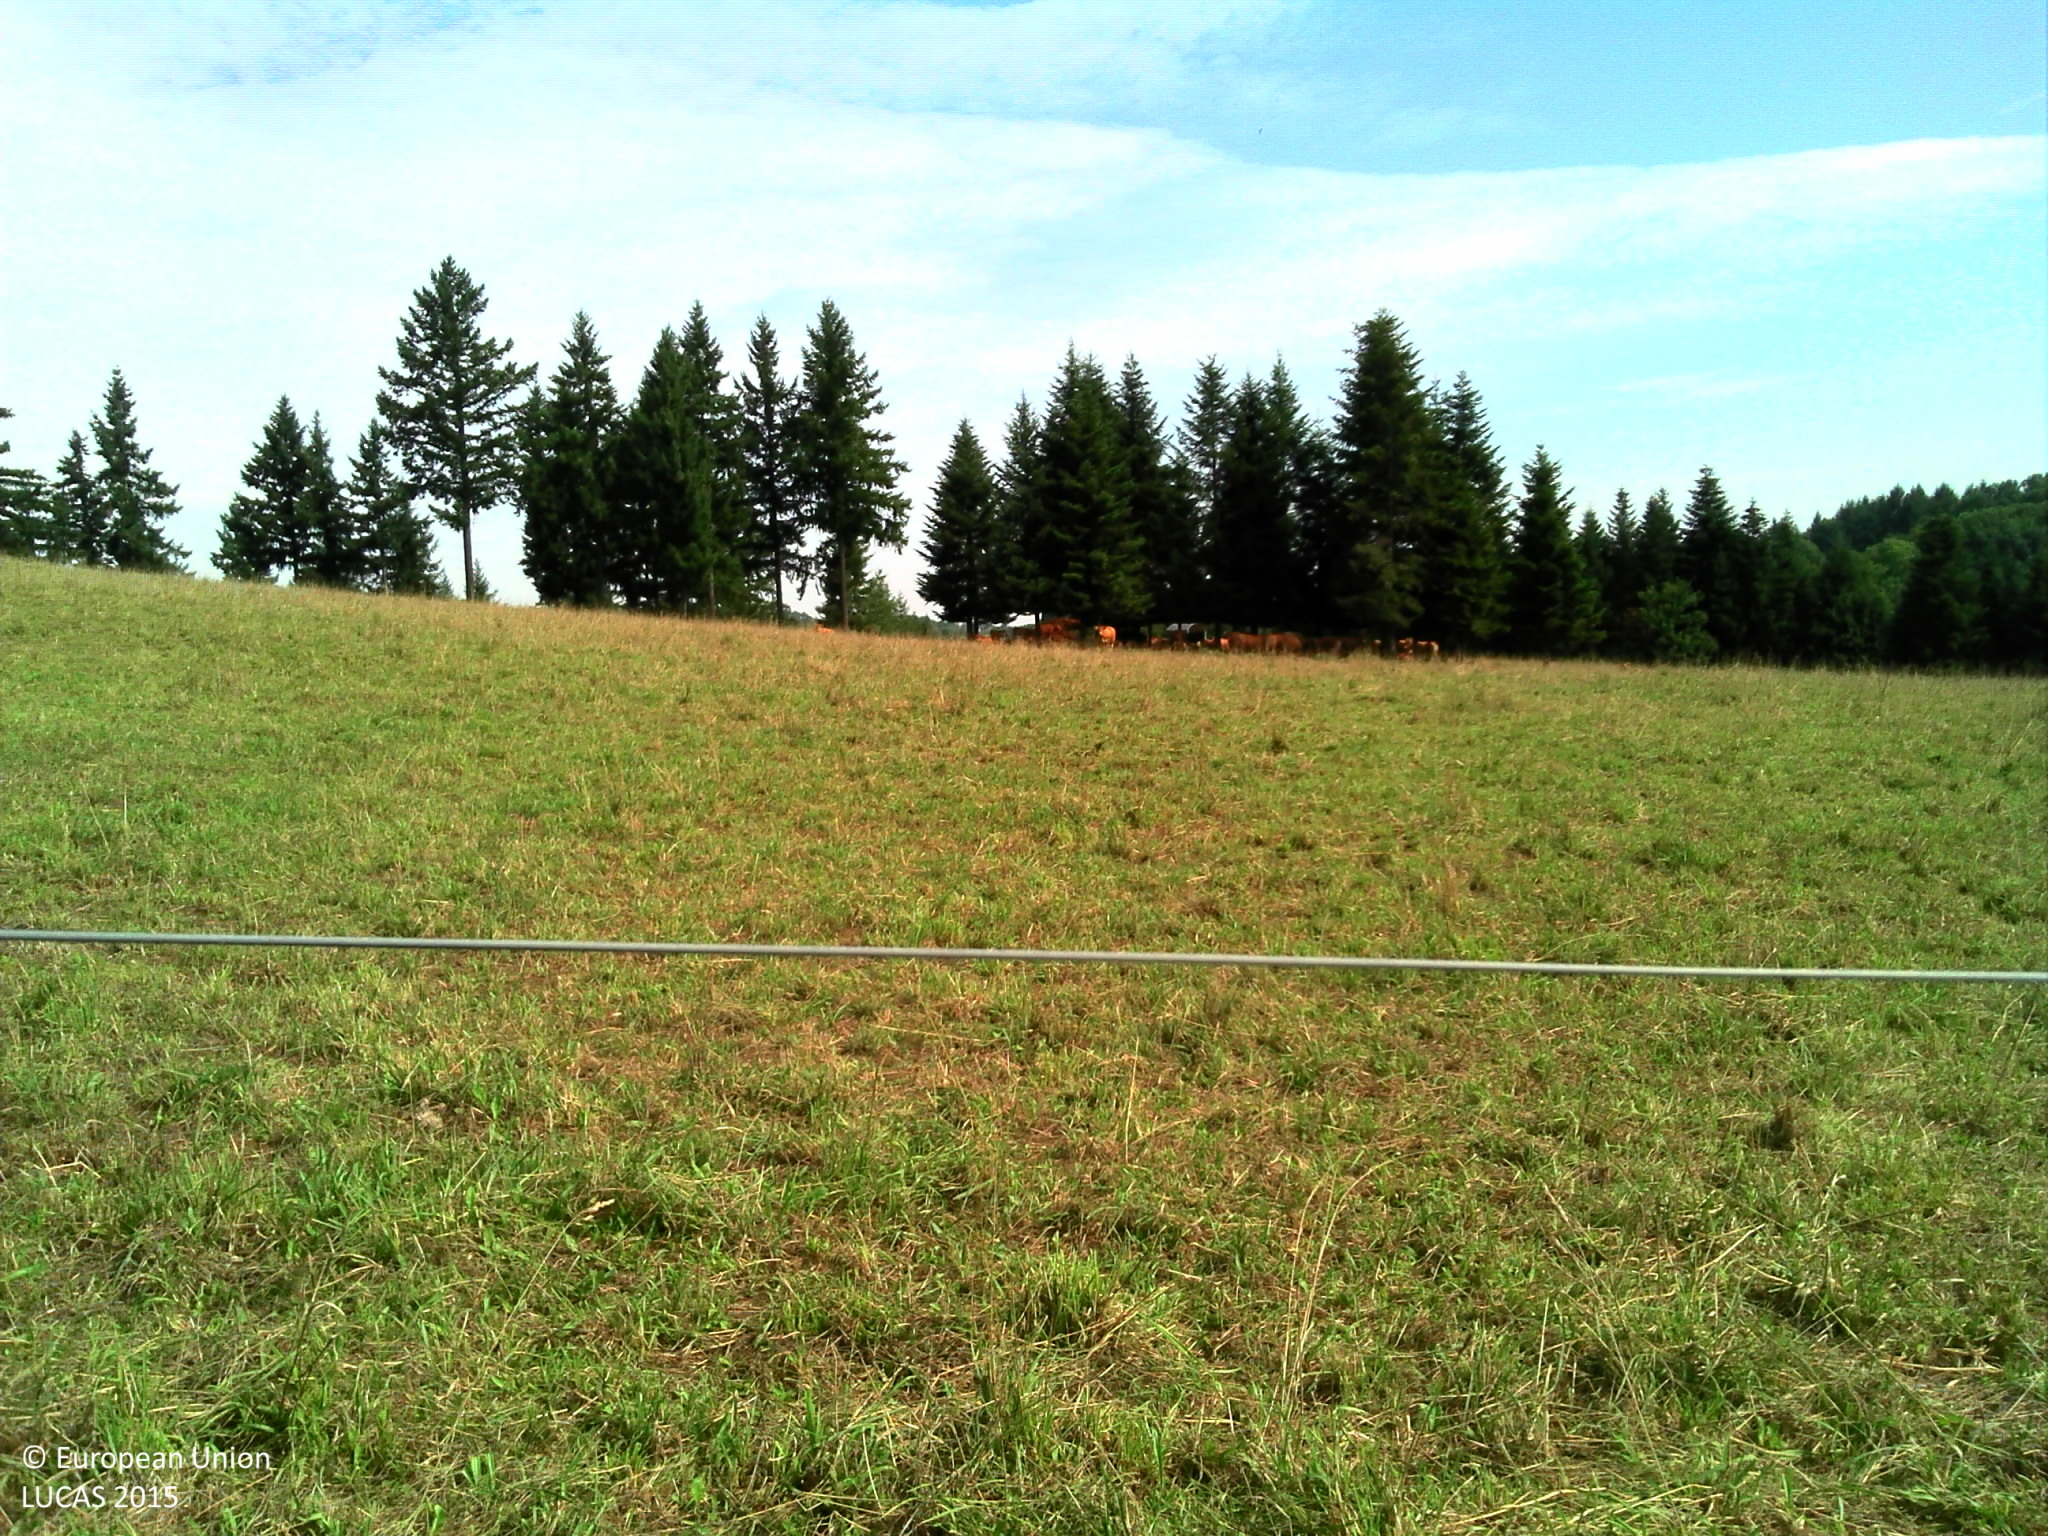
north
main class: Grassland
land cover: Grassland without tree/shrub cover
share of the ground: > 75 %
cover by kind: herbaceous plants 95 %
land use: Agriculture (excluding fallow land and kitchen gardens)
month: August
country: FR
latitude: 45.6145
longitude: 1.2846
